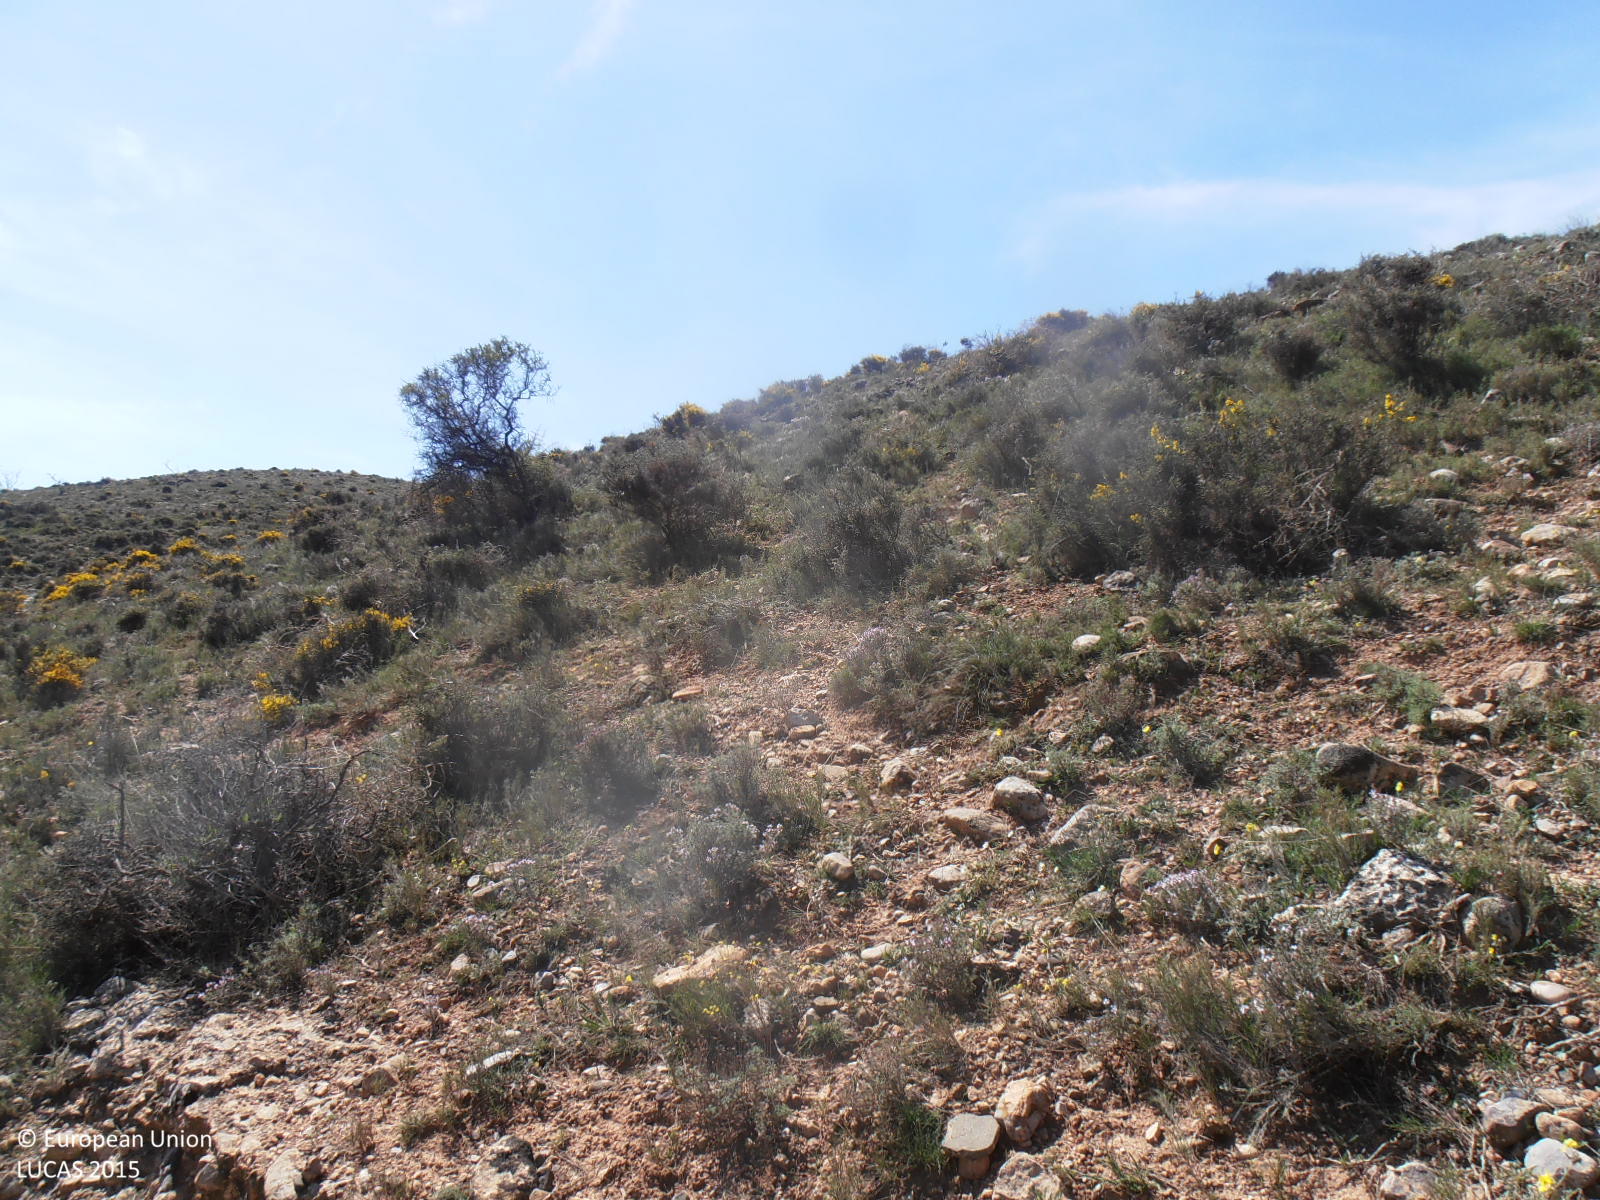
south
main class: Shrubland
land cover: Shrubland without tree cover
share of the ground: 50 - 75 %
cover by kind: shrubs 60 %, consolidated bare surface 25 %, herbaceous plants 15 %
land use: Semi-natural and natural areas not in use
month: April
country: ES
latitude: 41.2251
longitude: -0.9093
